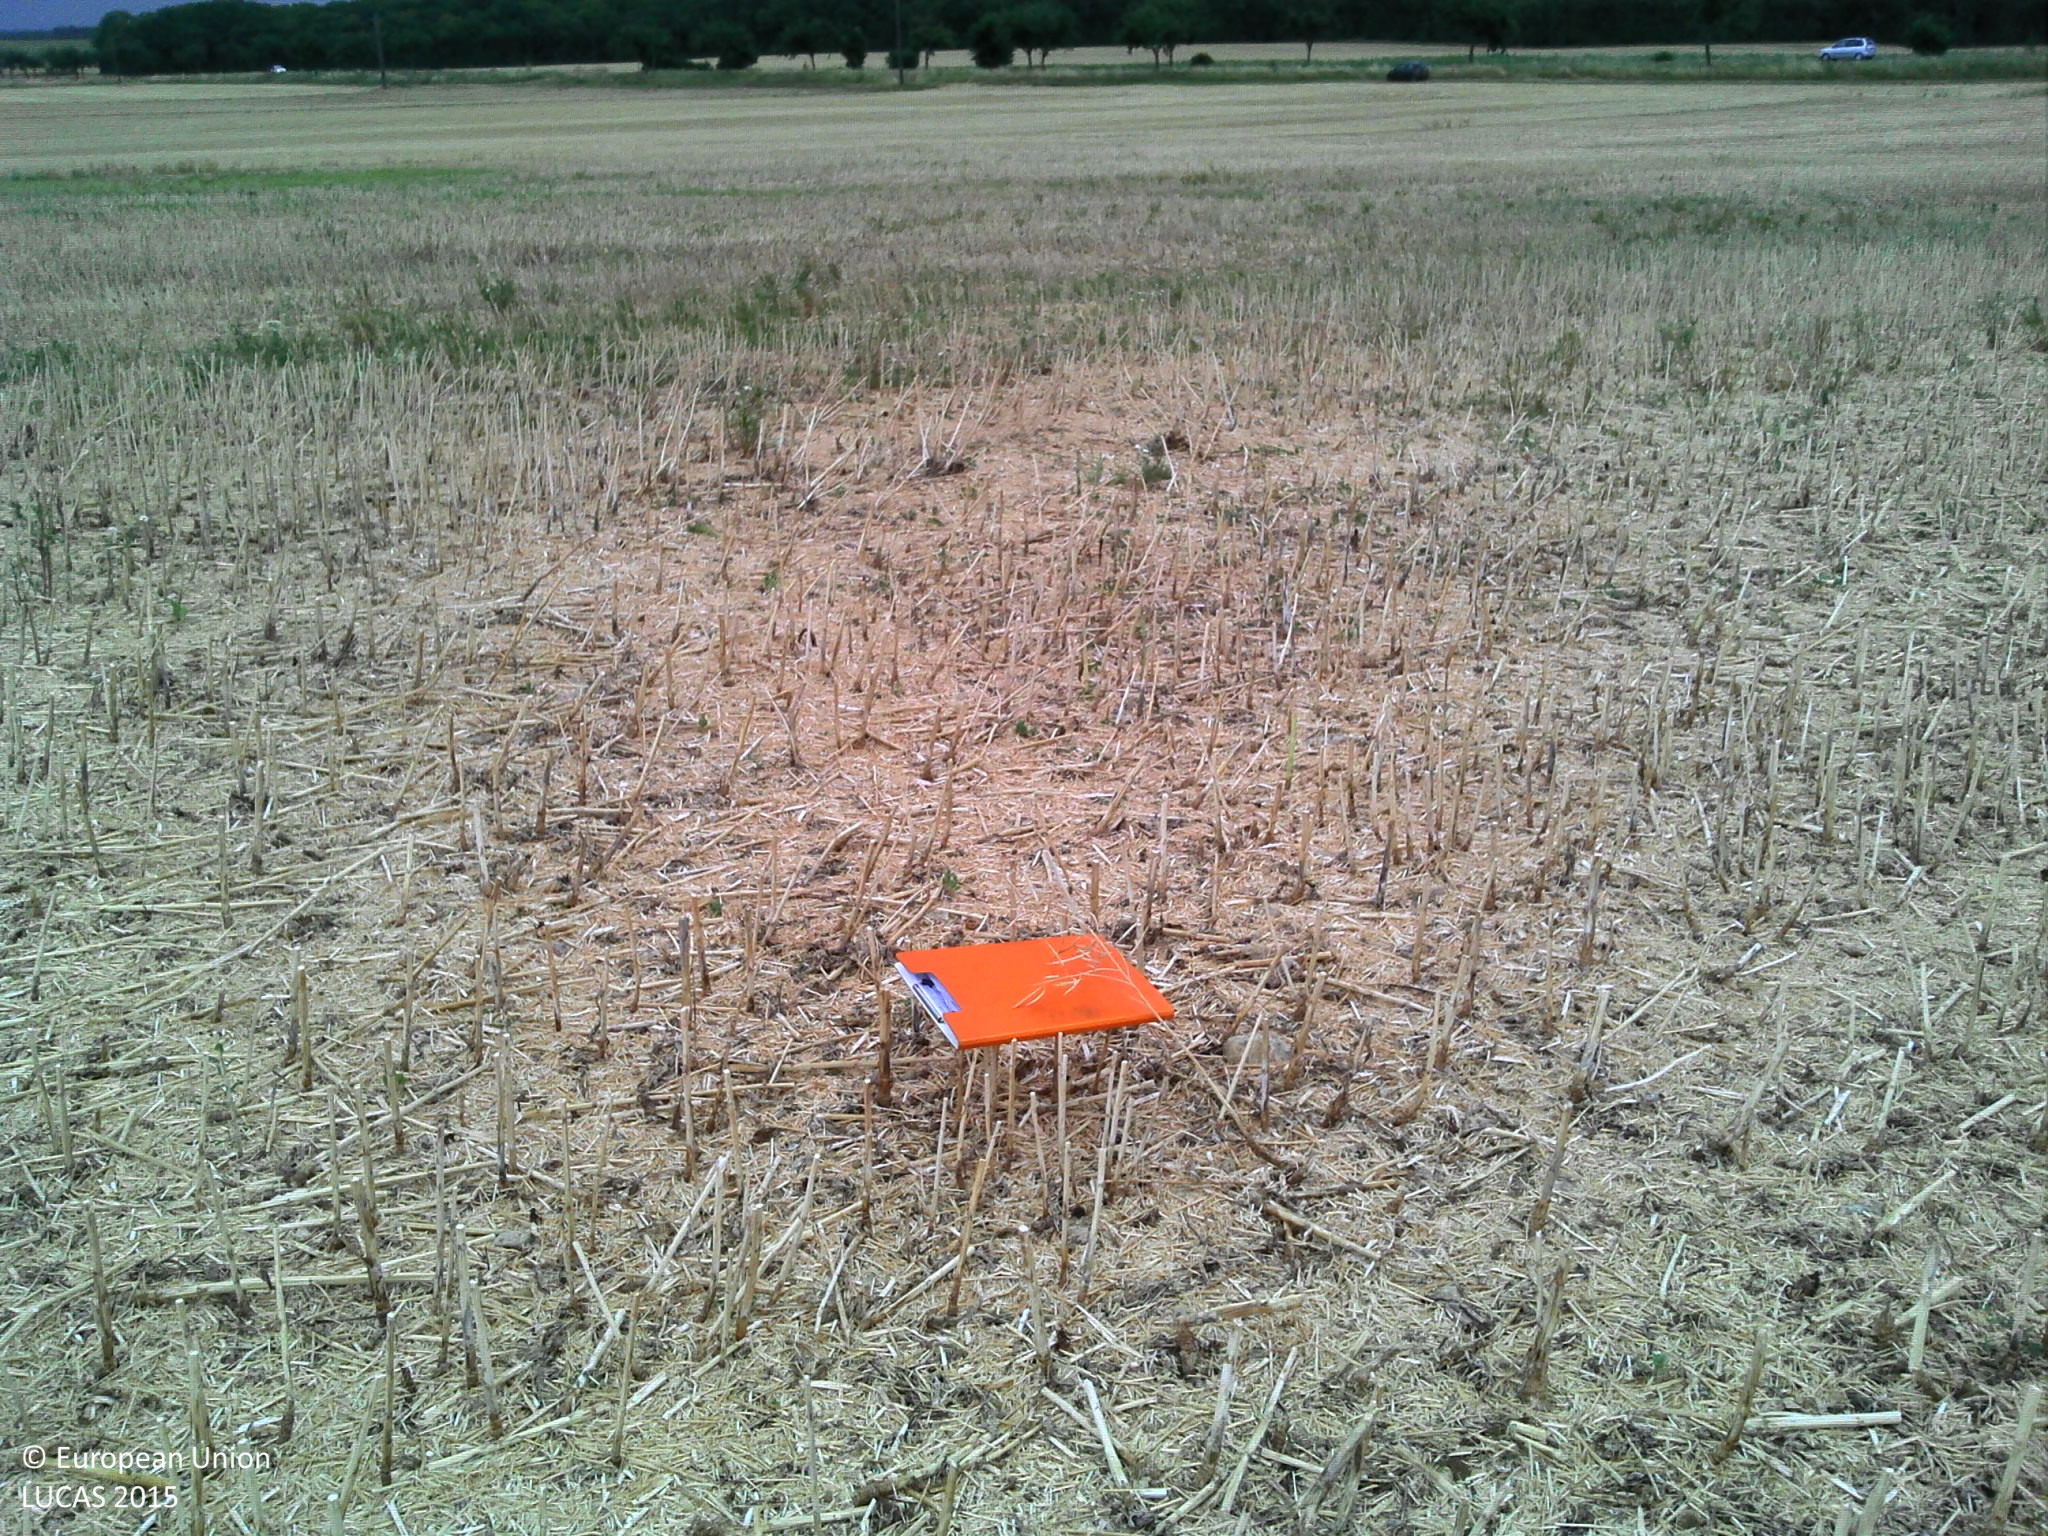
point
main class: Cropland
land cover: Rape and turnip rape
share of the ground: 10 - 25 %
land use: Agriculture (excluding fallow land and kitchen gardens)
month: July
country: FR
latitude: 47.9049
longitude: 5.2505
